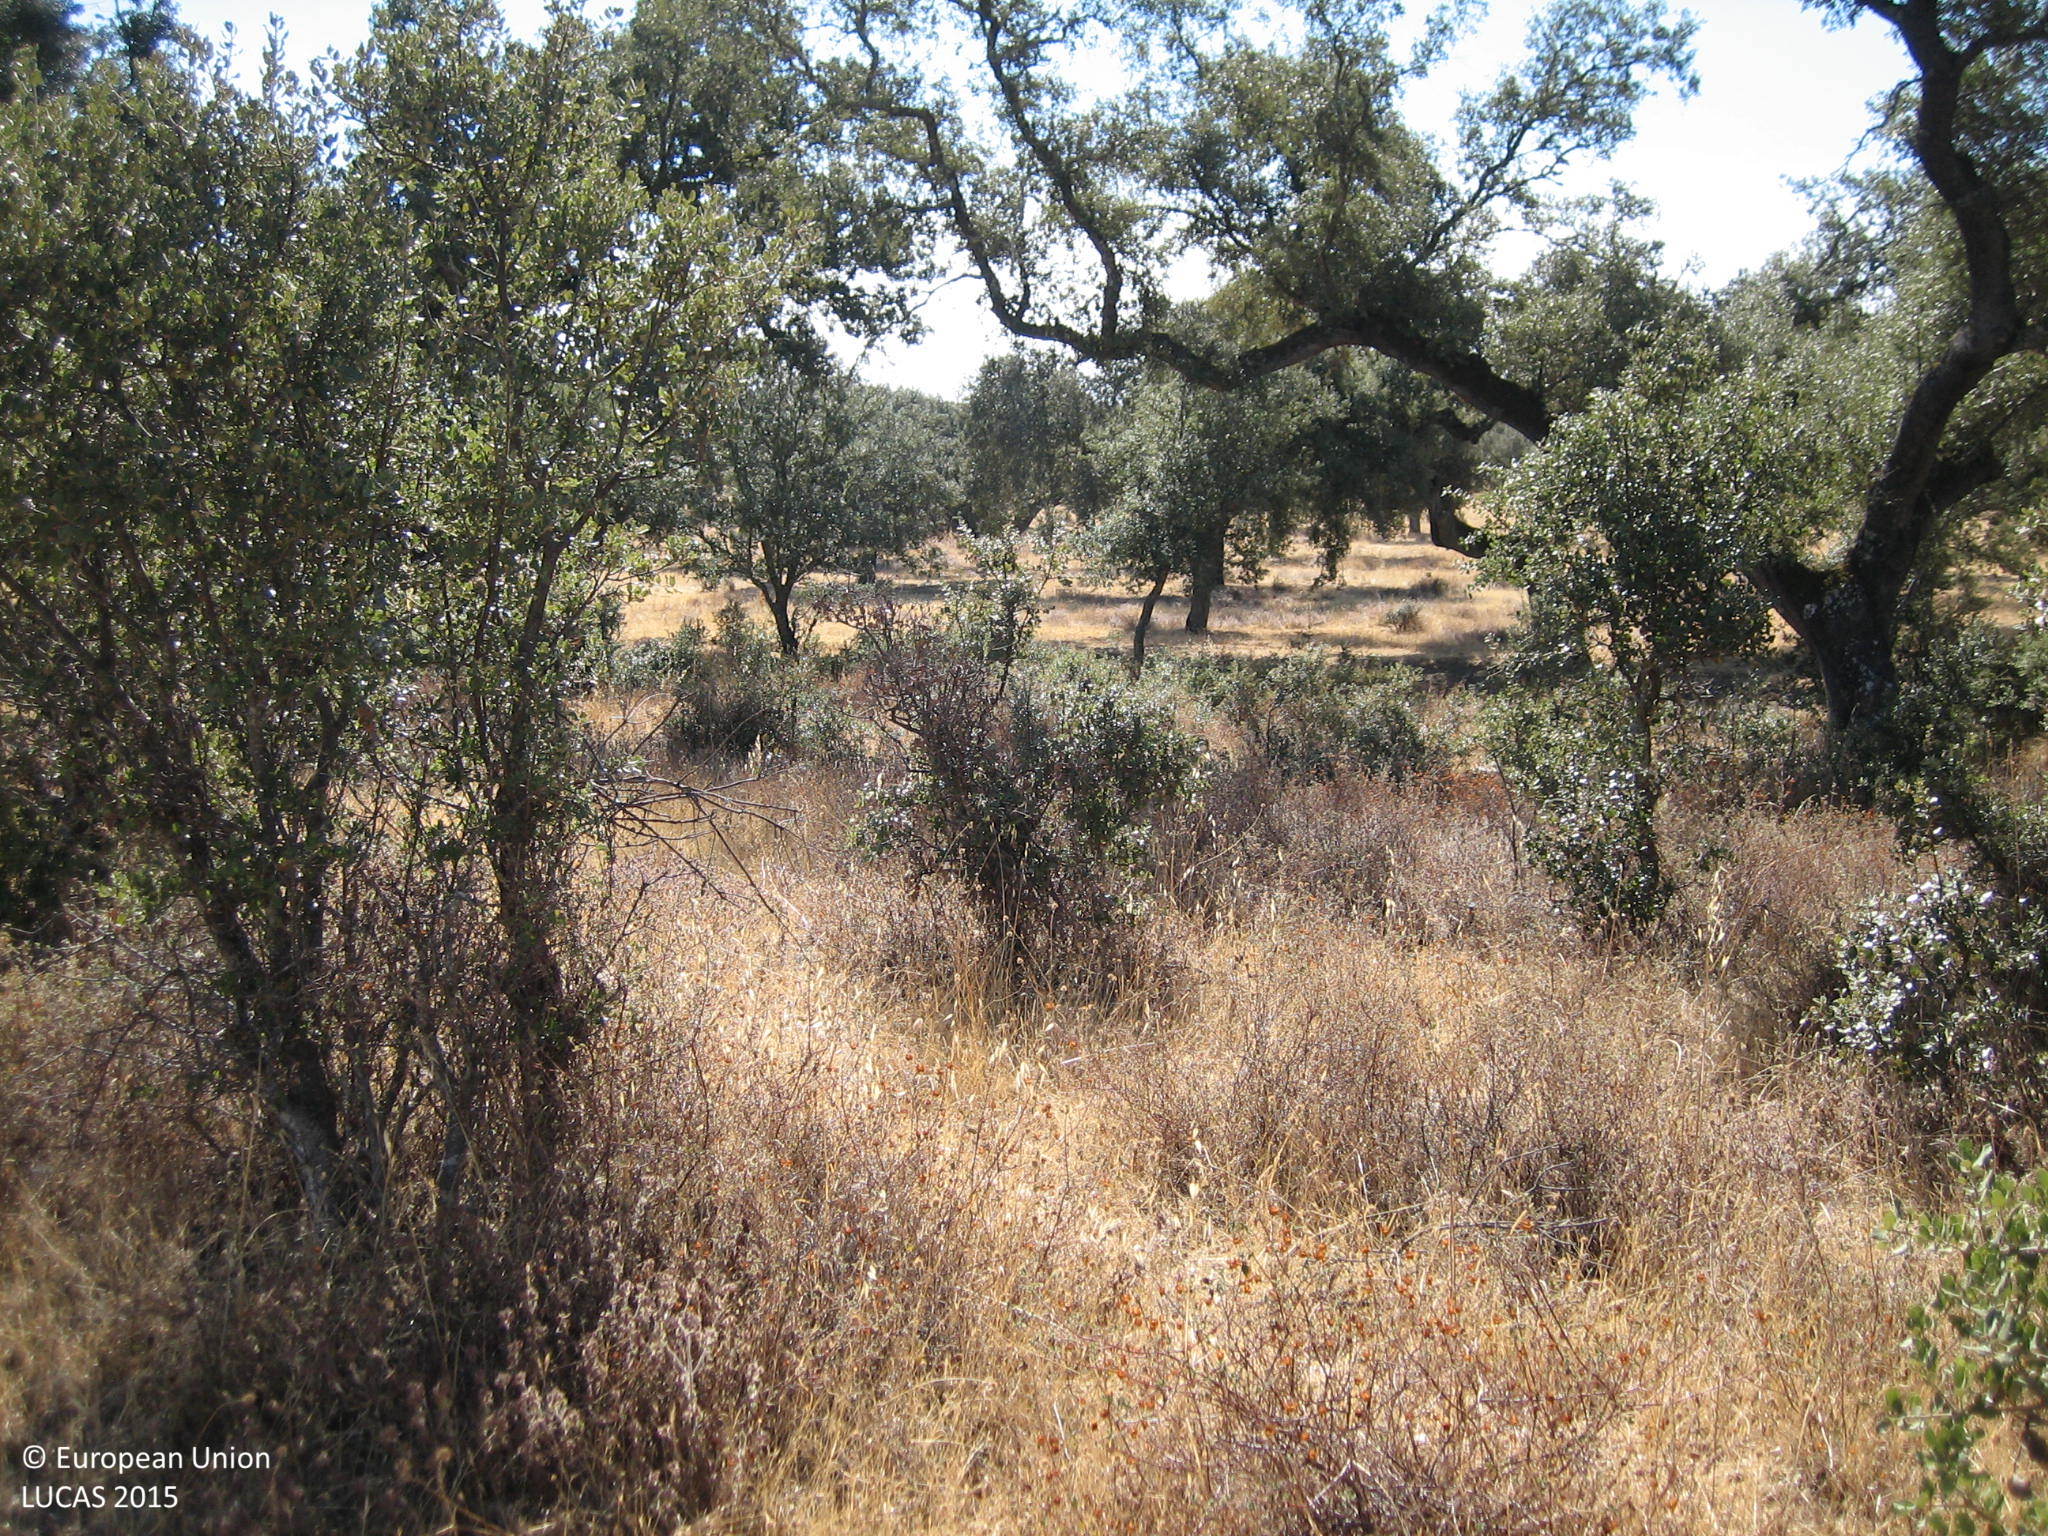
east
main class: Woodland
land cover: Broadleaved woodland
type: broadleaved evergreen forest
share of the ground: 10 - 25 %
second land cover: Shrubland without tree cover
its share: 10 - 25 %
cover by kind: herbaceous plants 40 %, broadleaved forest trees 20 %, shrubs 20 %, unconsolidated bare surface 20 %
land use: Forestry
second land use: Agriculture (excluding fallow land and kitchen gardens)
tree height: > 5 m
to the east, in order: Broadleaved woodland; Shrubland without tree cover; Tracks; Grassland without tree/shrub cover; Broadleaved woodland
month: August
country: ES
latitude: 38.5115
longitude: -7.2132
